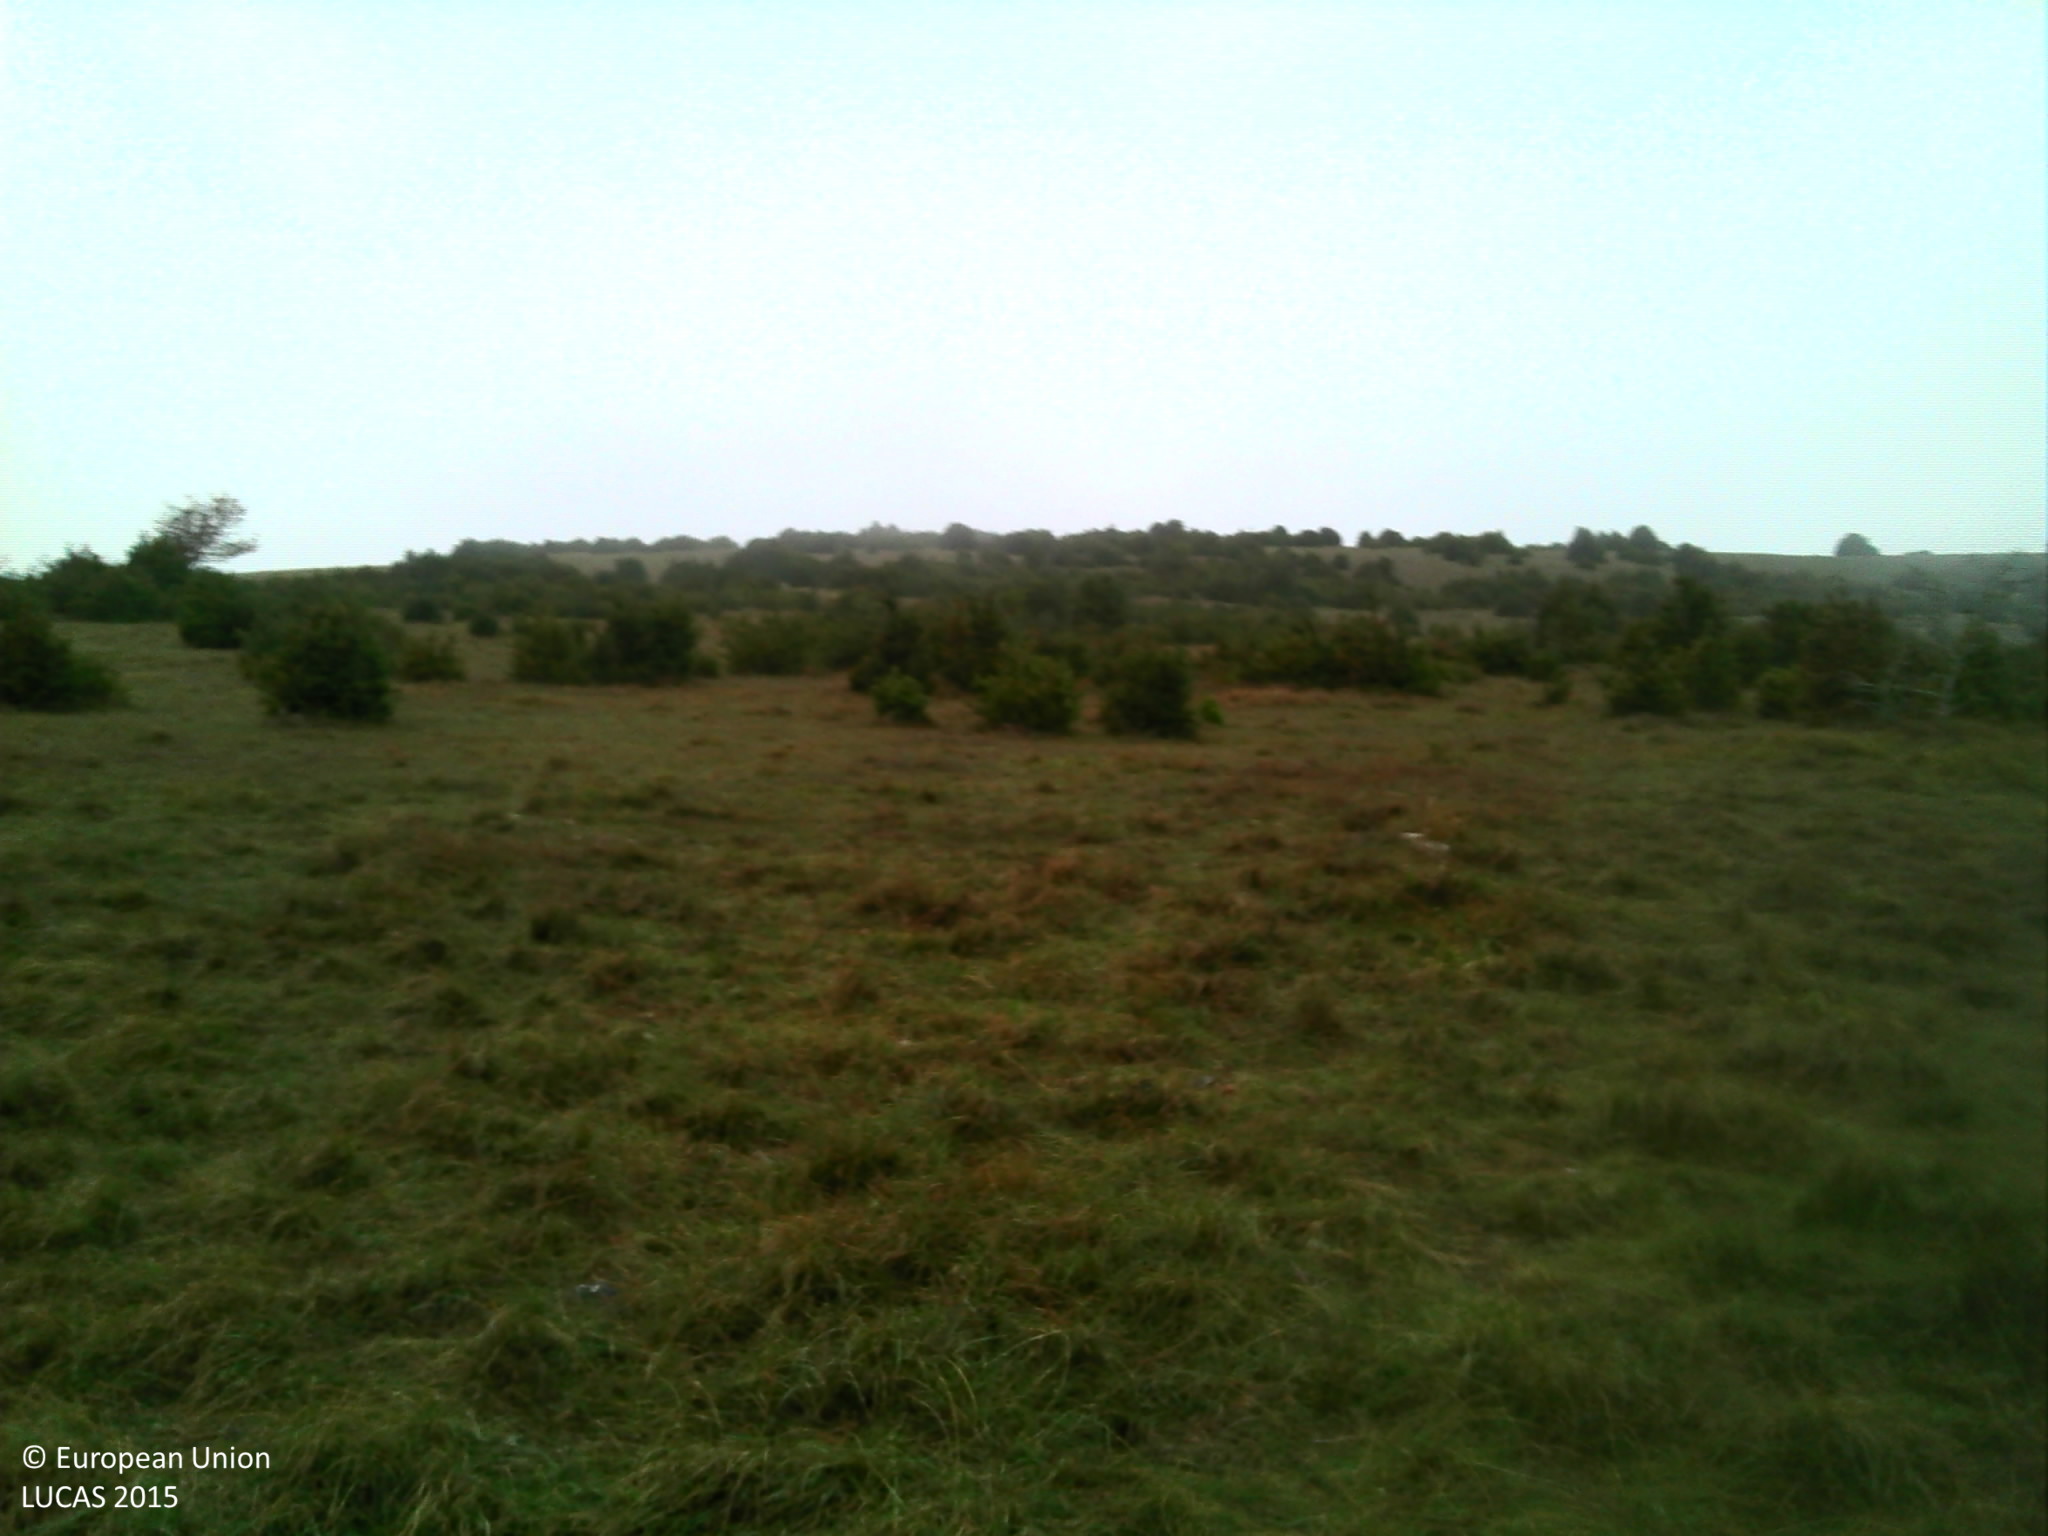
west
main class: Grassland
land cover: Grassland without tree/shrub cover
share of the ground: > 75 %
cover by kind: herbaceous plants 100 %
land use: Agriculture (excluding fallow land and kitchen gardens)
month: November
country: FR
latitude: 44.0290
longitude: 3.0815
